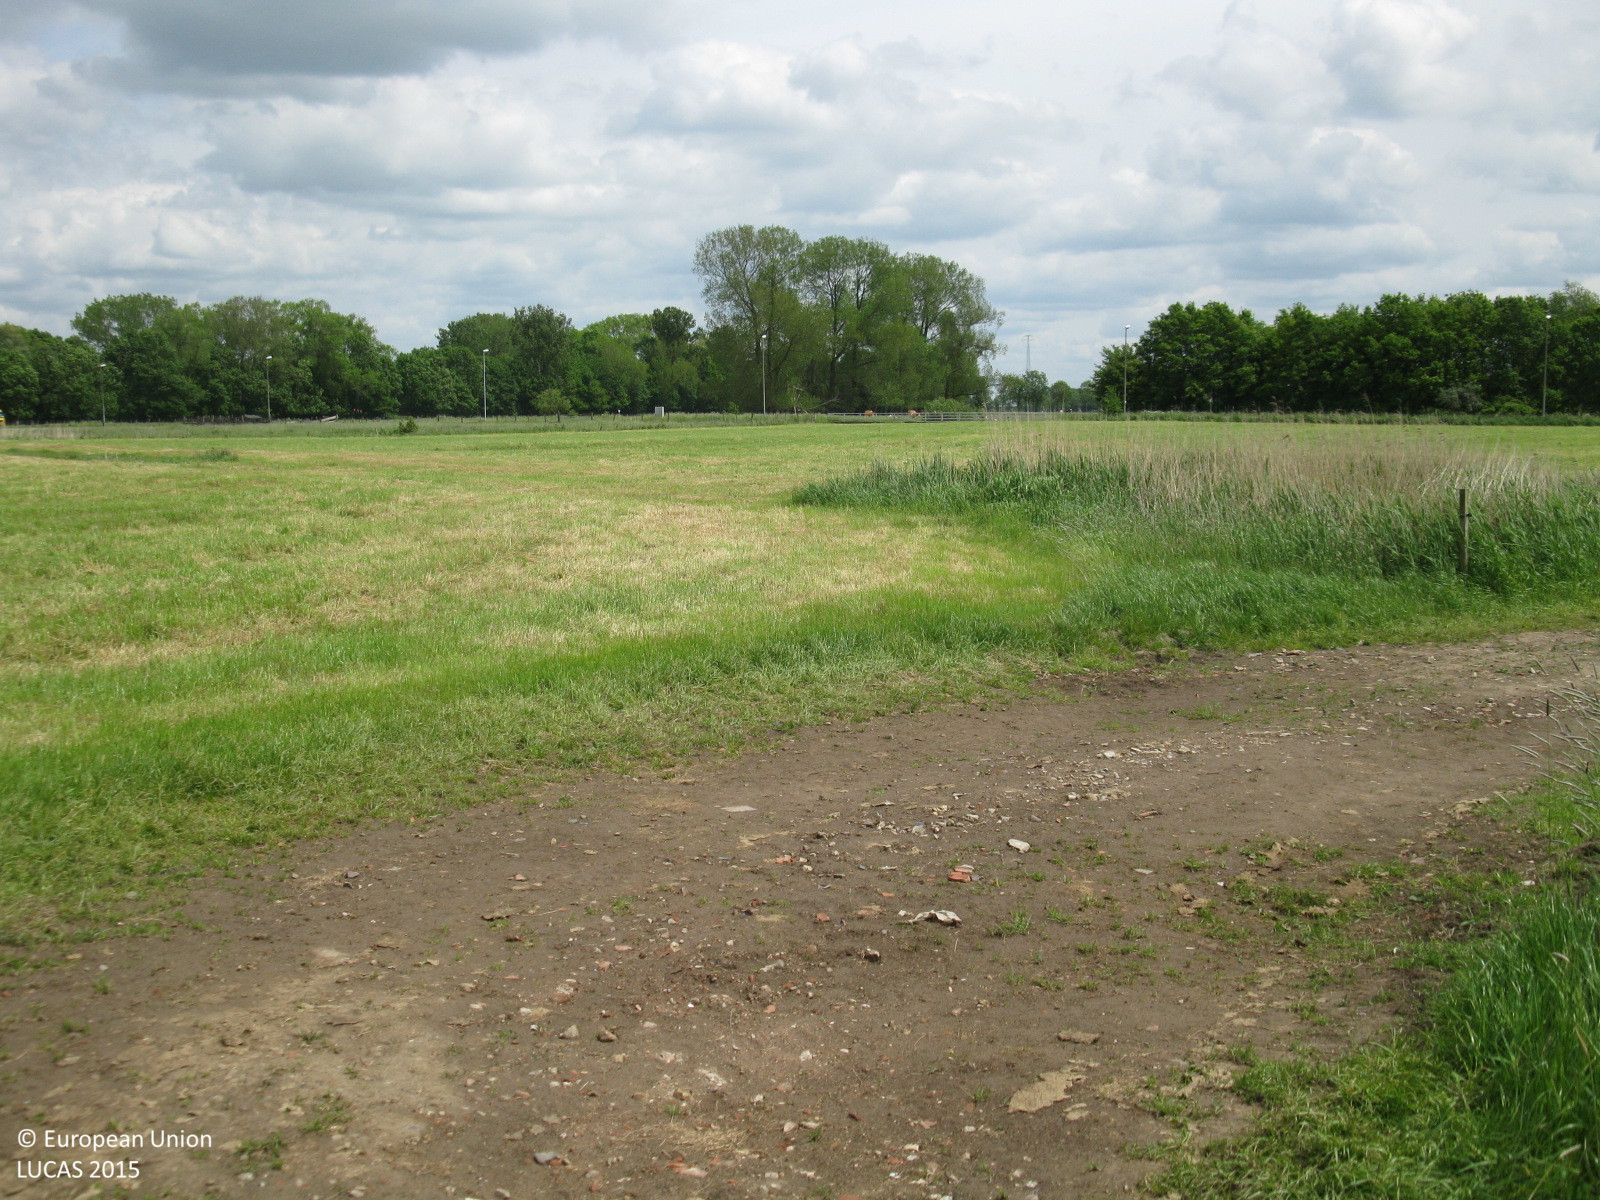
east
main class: Grassland
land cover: Grassland without tree/shrub cover
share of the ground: > 75 %
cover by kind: herbaceous plants 100 %
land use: Agriculture (excluding fallow land and kitchen gardens)
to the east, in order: Grassland without tree/shrub cover; Fences; Ditches and canals; Fences; Grassland without tree/shrub cover; Fences; Tracks; Grass margins; Ditches and canals; Grassland without tree/shrub cover
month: June
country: DE
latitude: 53.1752
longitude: 7.3524
